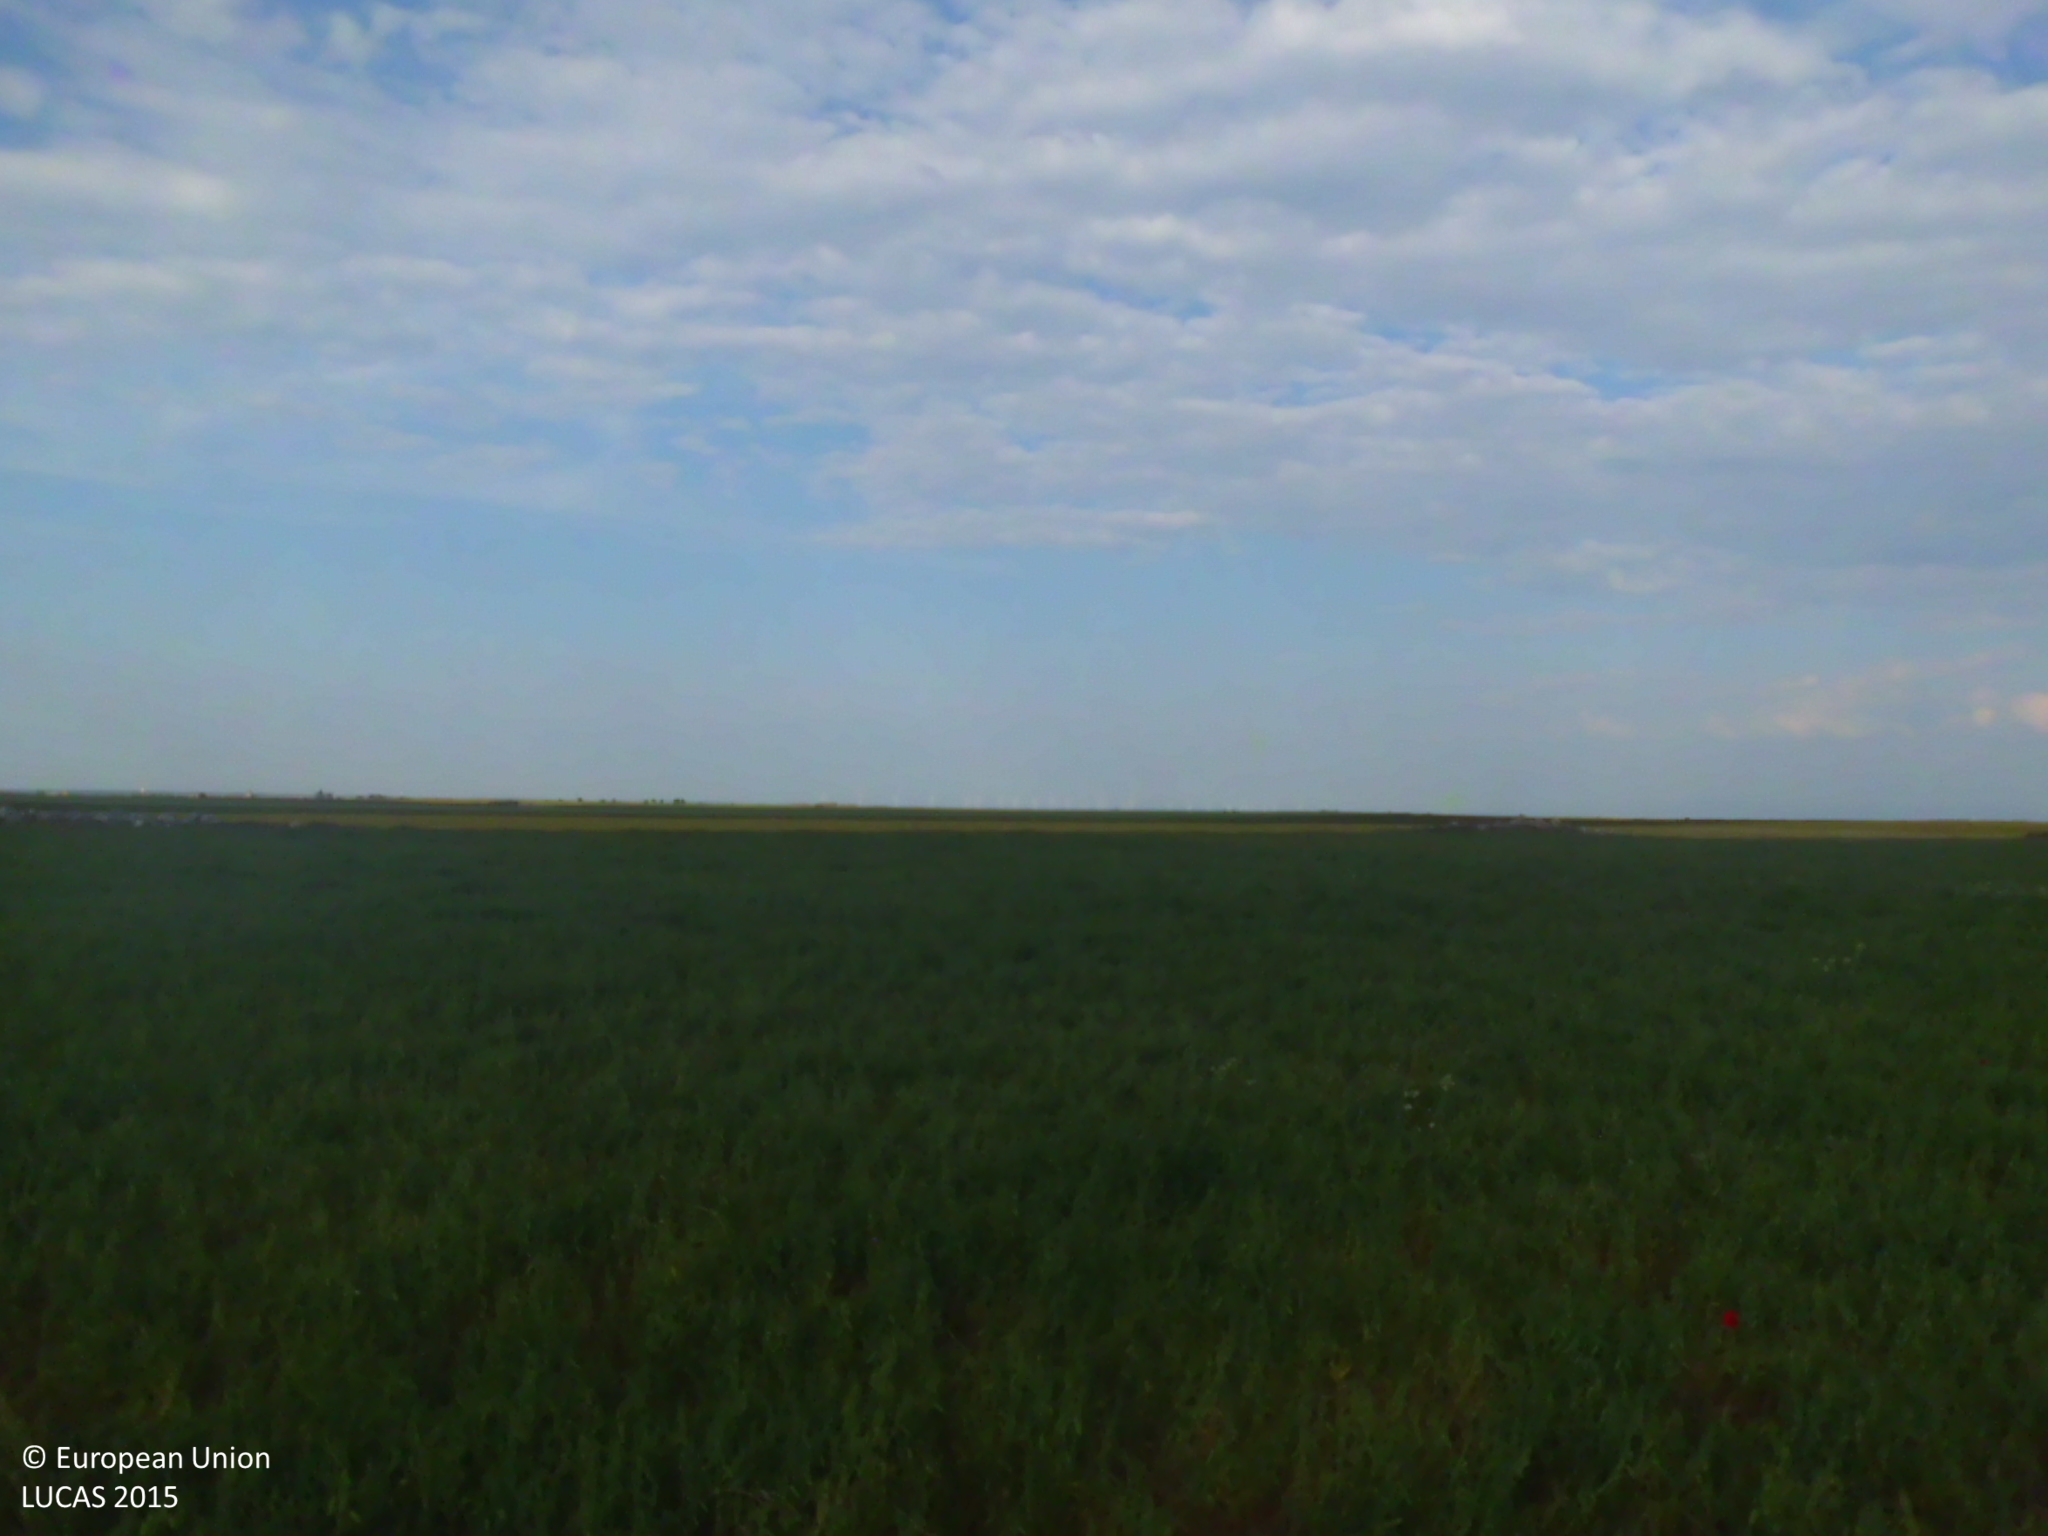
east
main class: Cropland
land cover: Dry pulses
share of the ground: > 75 %
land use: Agriculture (excluding fallow land and kitchen gardens)
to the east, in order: Dry pulses; Barley; Lucerne
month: June
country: ES
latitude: 42.4256
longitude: -4.0070
